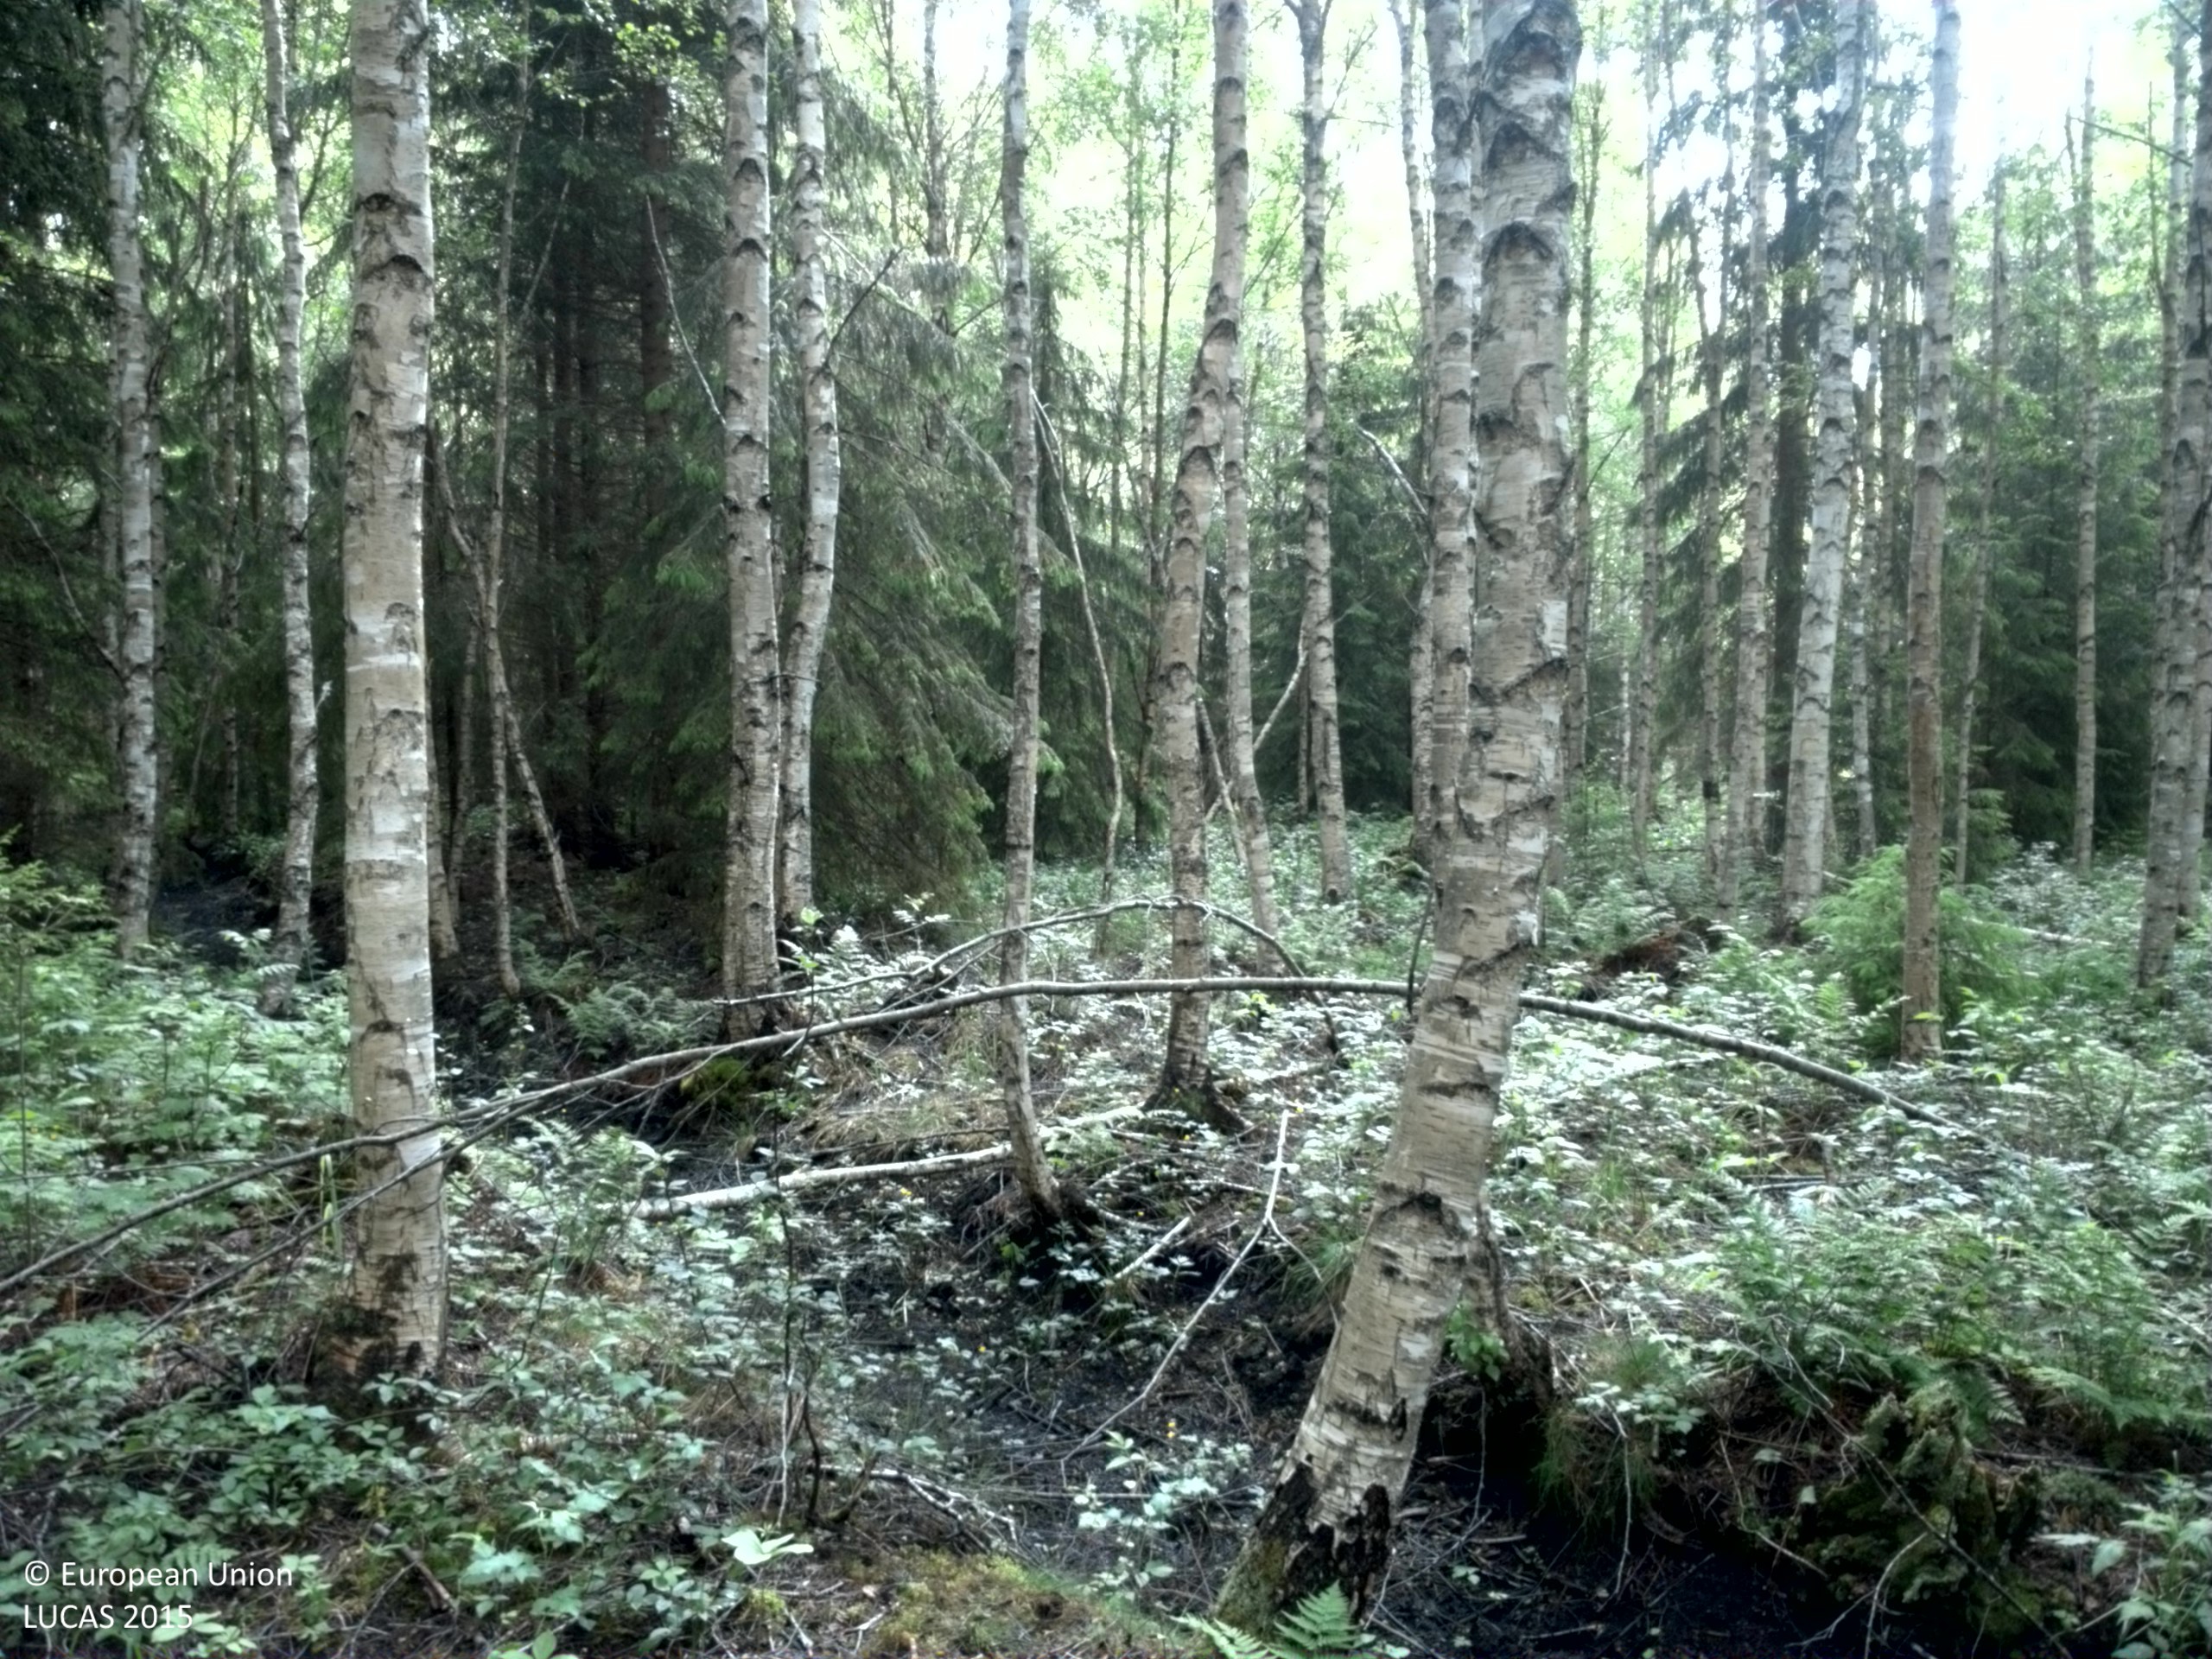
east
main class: Woodland
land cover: Broadleaved woodland
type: boreal forest
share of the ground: 50 - 75 %
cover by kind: broadleaved forest trees 65 %, herbaceous plants 20 %, coniferous forest trees 5 %, lichens and mosses 5 %
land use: Forestry
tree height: > 5 m
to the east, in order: Broadleaved woodland; Spruce dominated coniferous woodland; Spruce dominated mixed woodland; Broadleaved woodland; Pine dominated mixed woodland; Pine dominated coniferous woodland; Pine dominated mixed woodland; Tracks; Pine dominated mixed woodland; Ditches and canals; Spruce dominated mixed woodland; Pine dominated mixed woodland
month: June
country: SE
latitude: 60.3346
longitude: 17.6542
